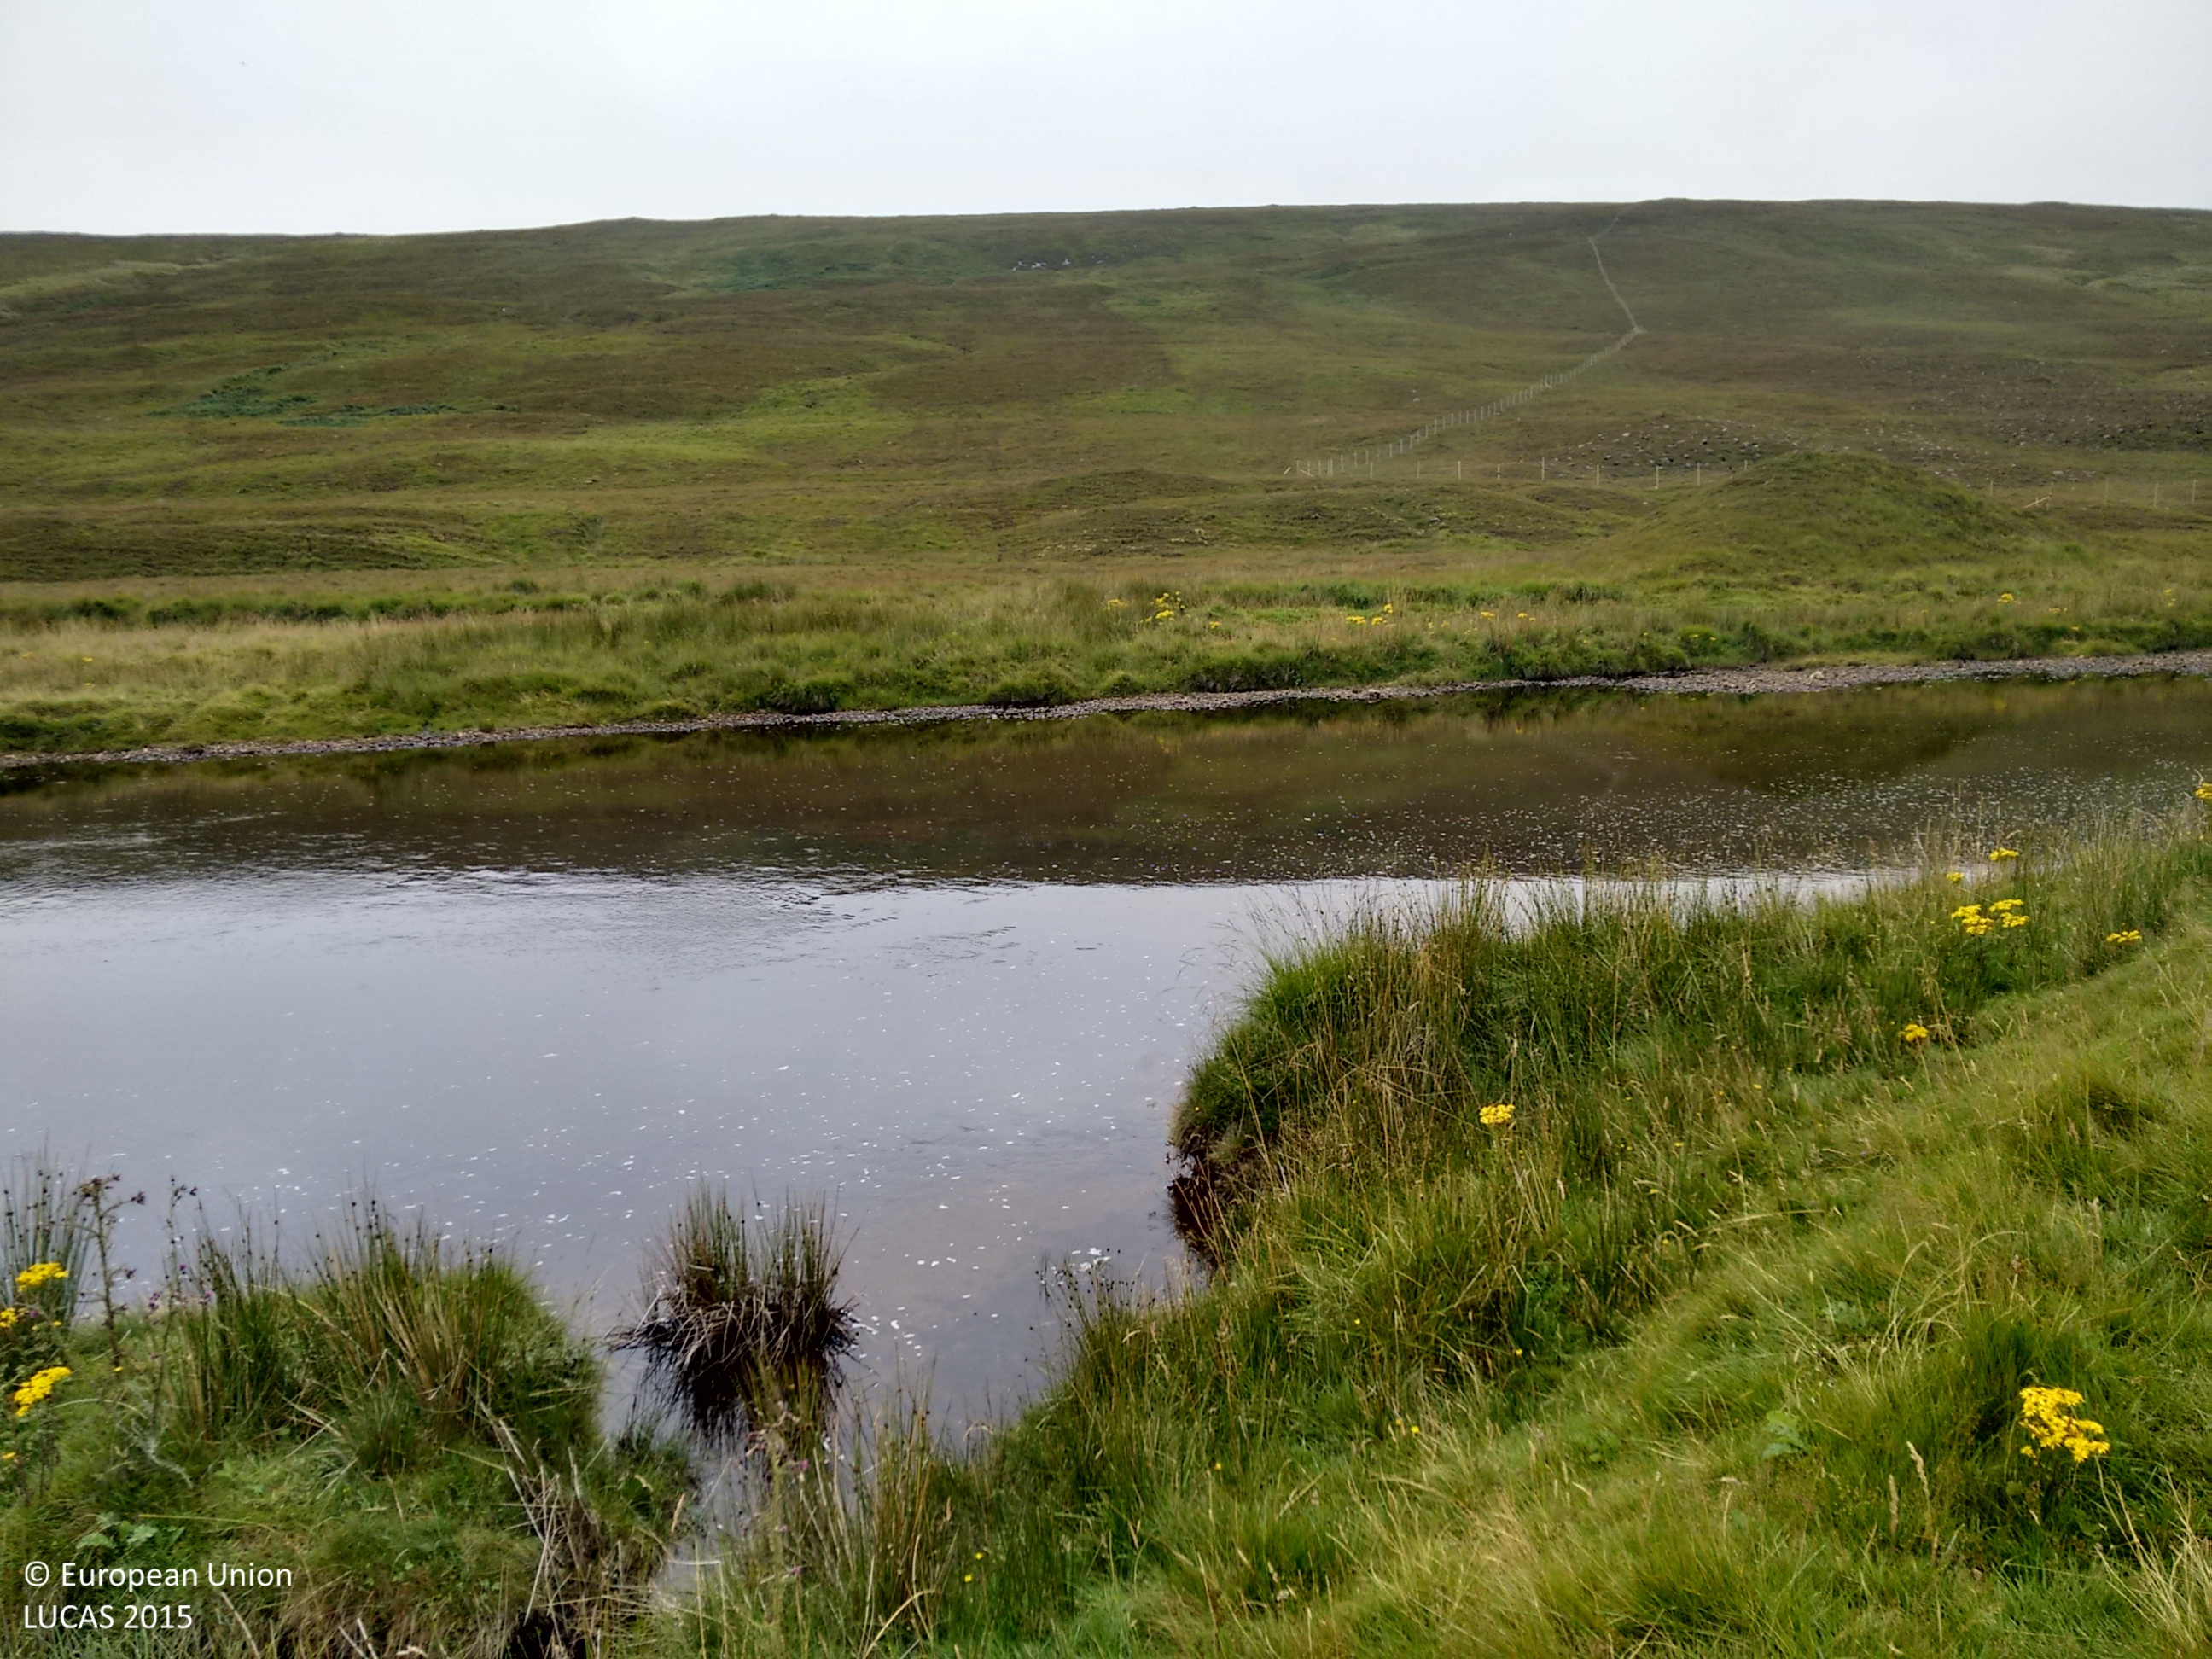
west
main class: Shrubland
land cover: Shrubland without tree cover
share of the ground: > 75 %
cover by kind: shrubs 75 %, herbaceous plants 25 %
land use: Agriculture (excluding fallow land and kitchen gardens)
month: September
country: GB
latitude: 58.0977
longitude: -4.7341
